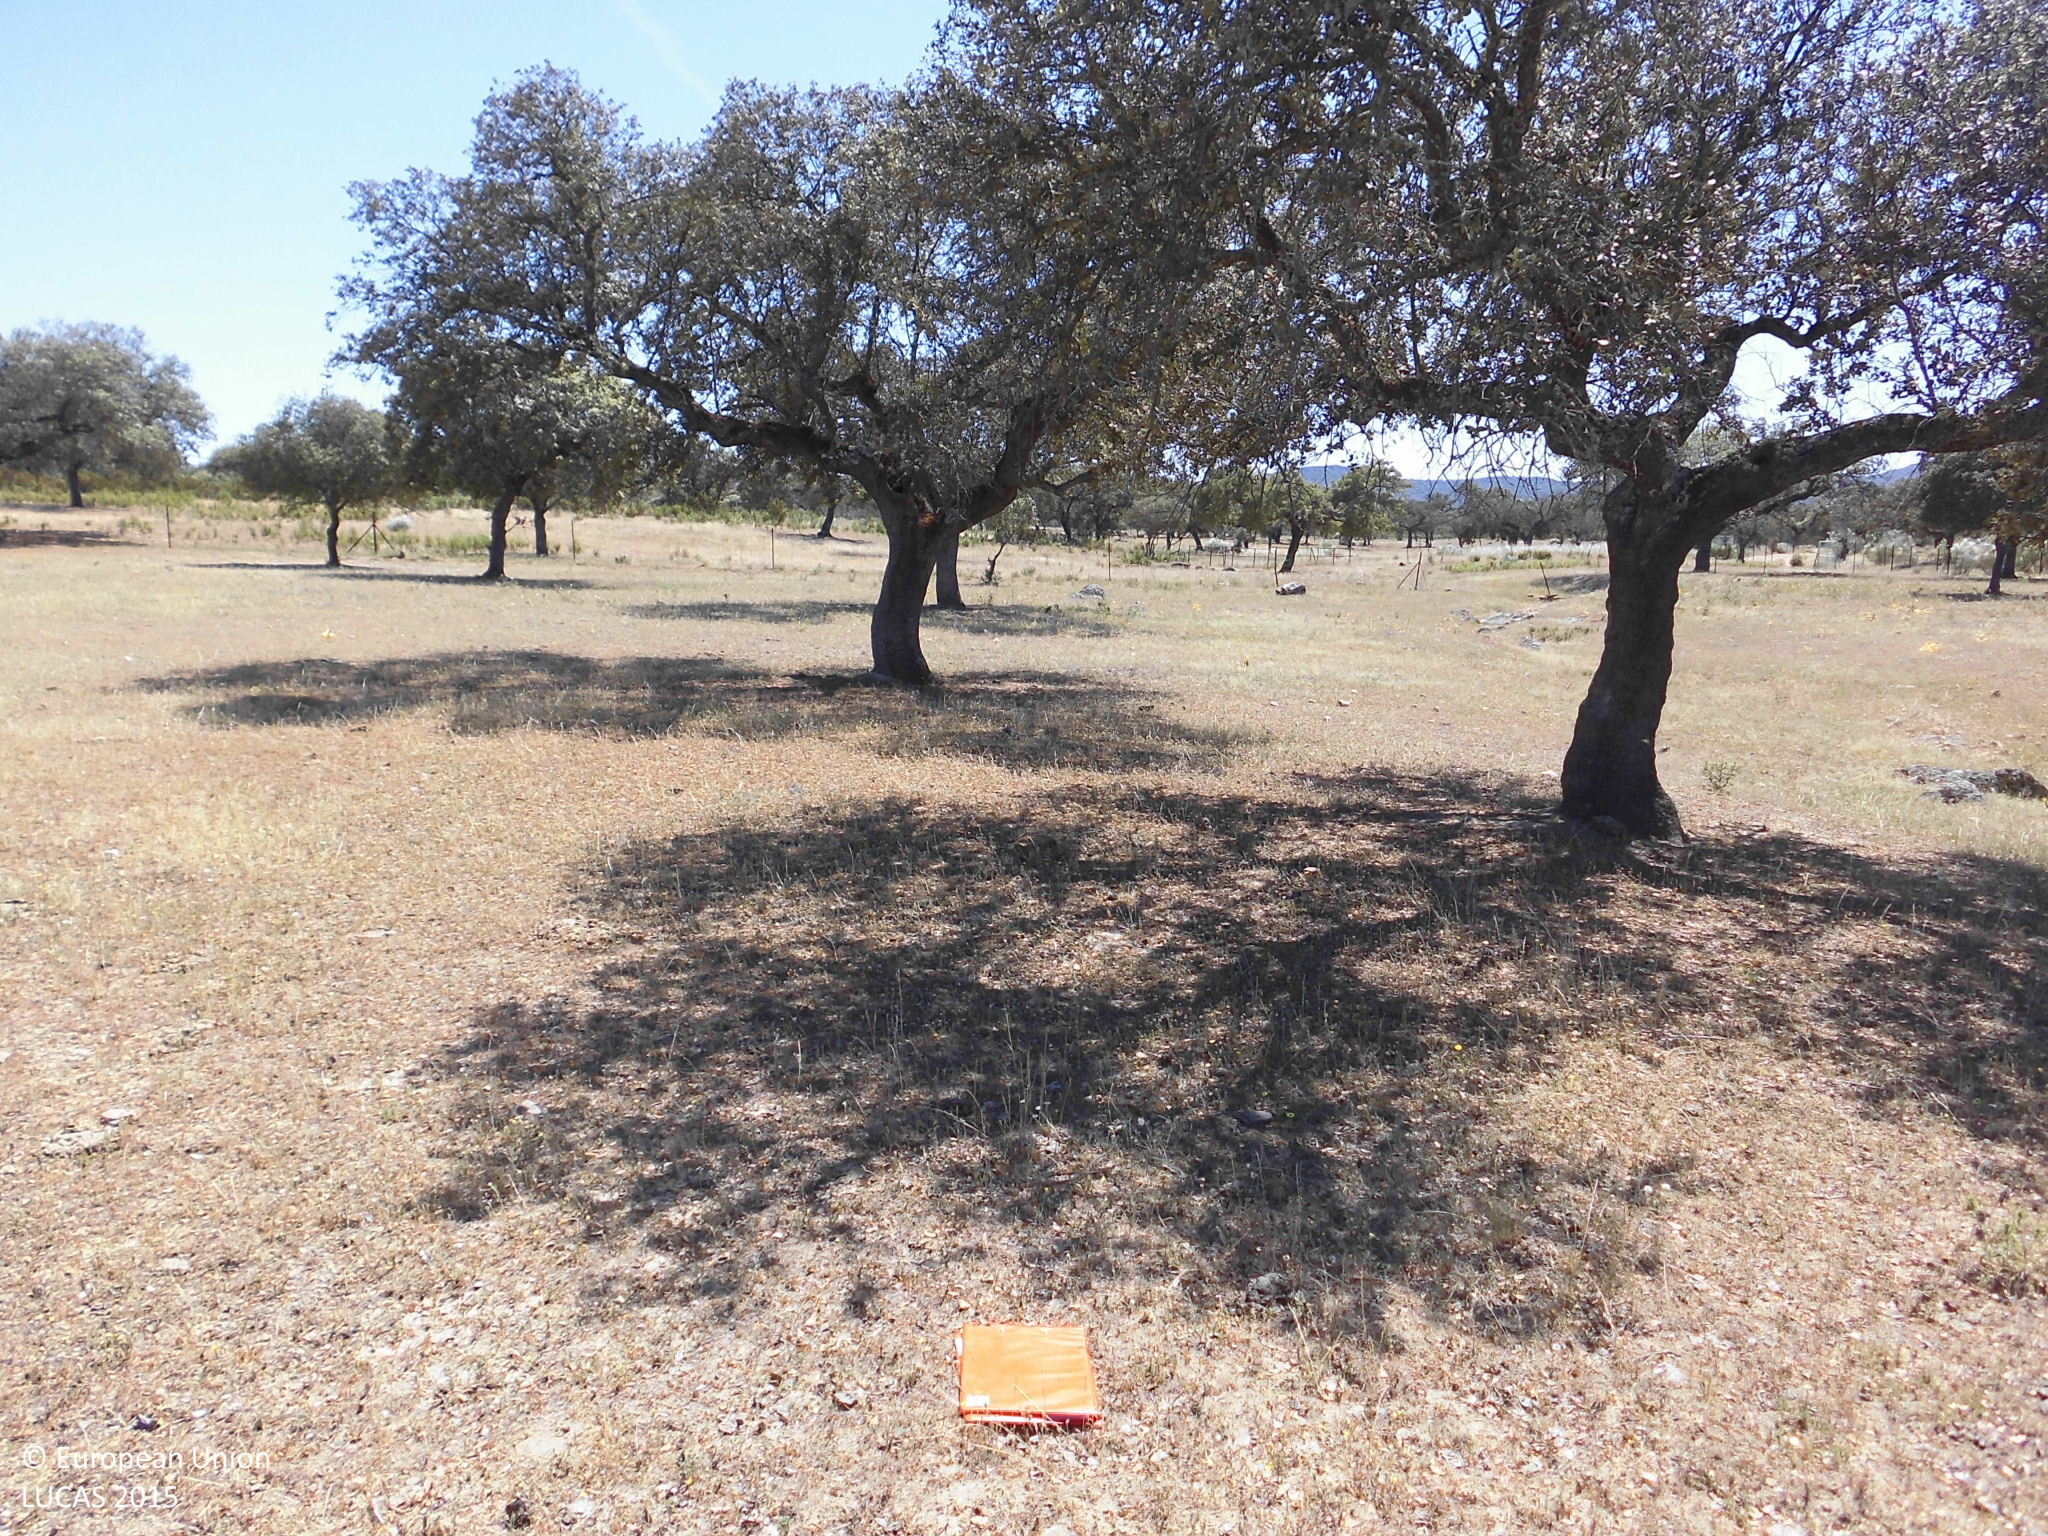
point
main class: Woodland
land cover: Broadleaved woodland
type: broadleaved evergreen forest
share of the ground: 10 - 25 %
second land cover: Grassland without tree/shrub cover
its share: > 75 %
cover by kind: herbaceous plants 80 %, broadleaved forest trees 20 %
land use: Forestry
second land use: Agriculture (excluding fallow land and kitchen gardens)
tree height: > 5 m
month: May
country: ES
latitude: 39.4500
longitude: -6.9173
